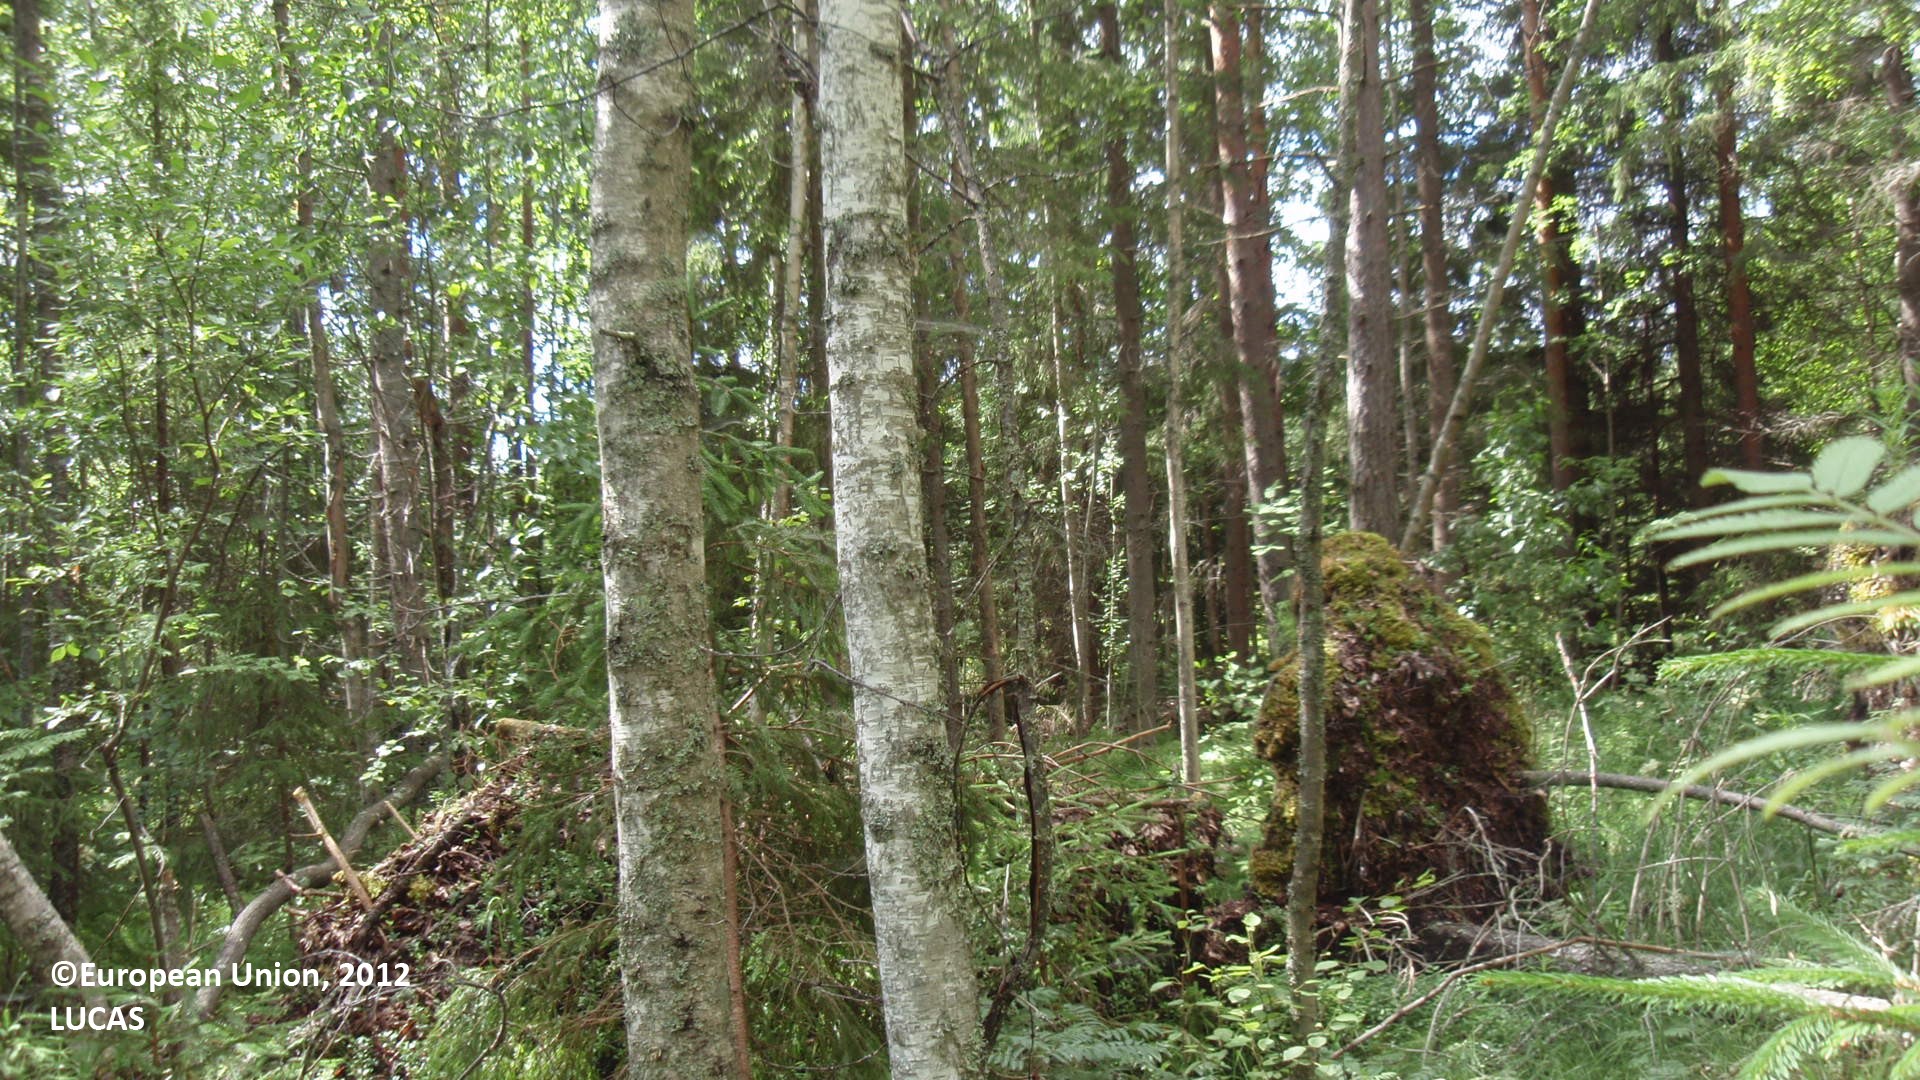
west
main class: Woodland
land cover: Spruce dominated mixed woodland
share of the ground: 50 - 75 %
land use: Forestry
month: July
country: FI
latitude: 61.6371
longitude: 27.4402
